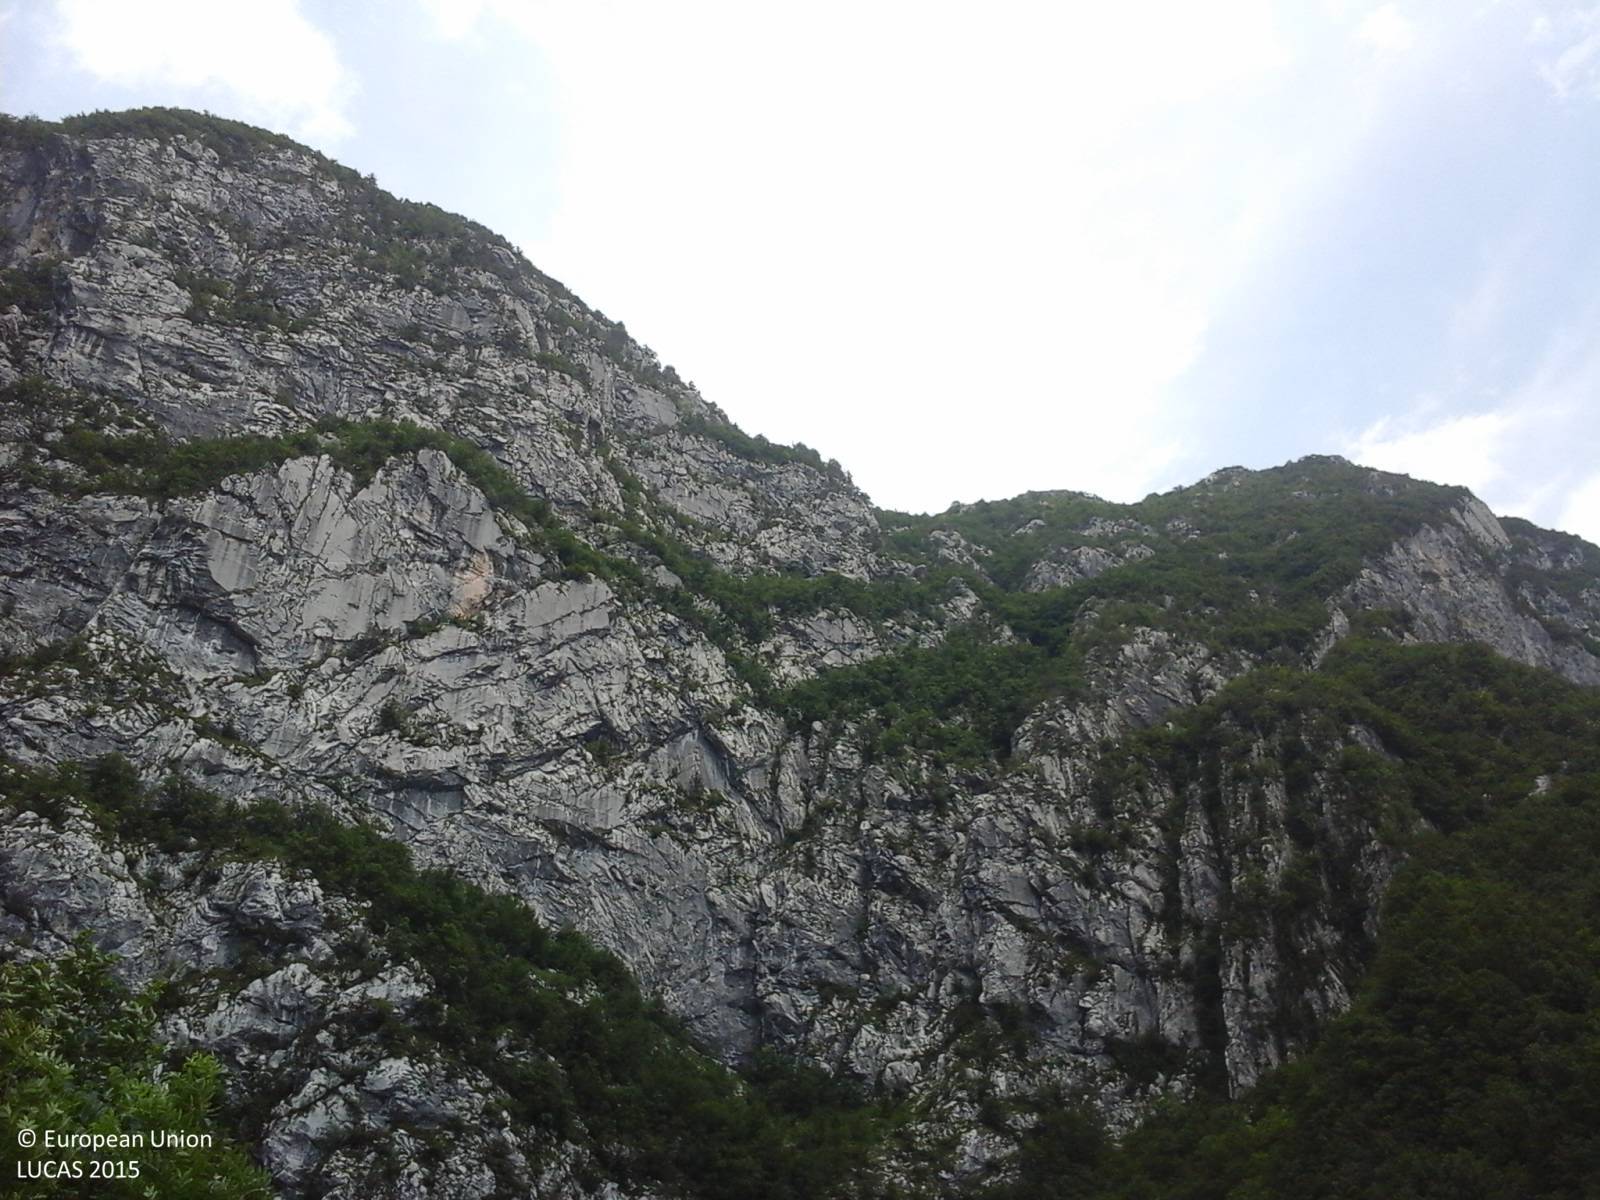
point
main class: Woodland
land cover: Broadleaved woodland
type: mountainous beech forest
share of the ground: > 75 %
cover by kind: broadleaved forest trees 80 %, coniferous forest trees 20 %
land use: Semi-natural and natural areas not in use
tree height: > 5 m
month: July
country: IT
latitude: 46.2505
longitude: 12.4746
